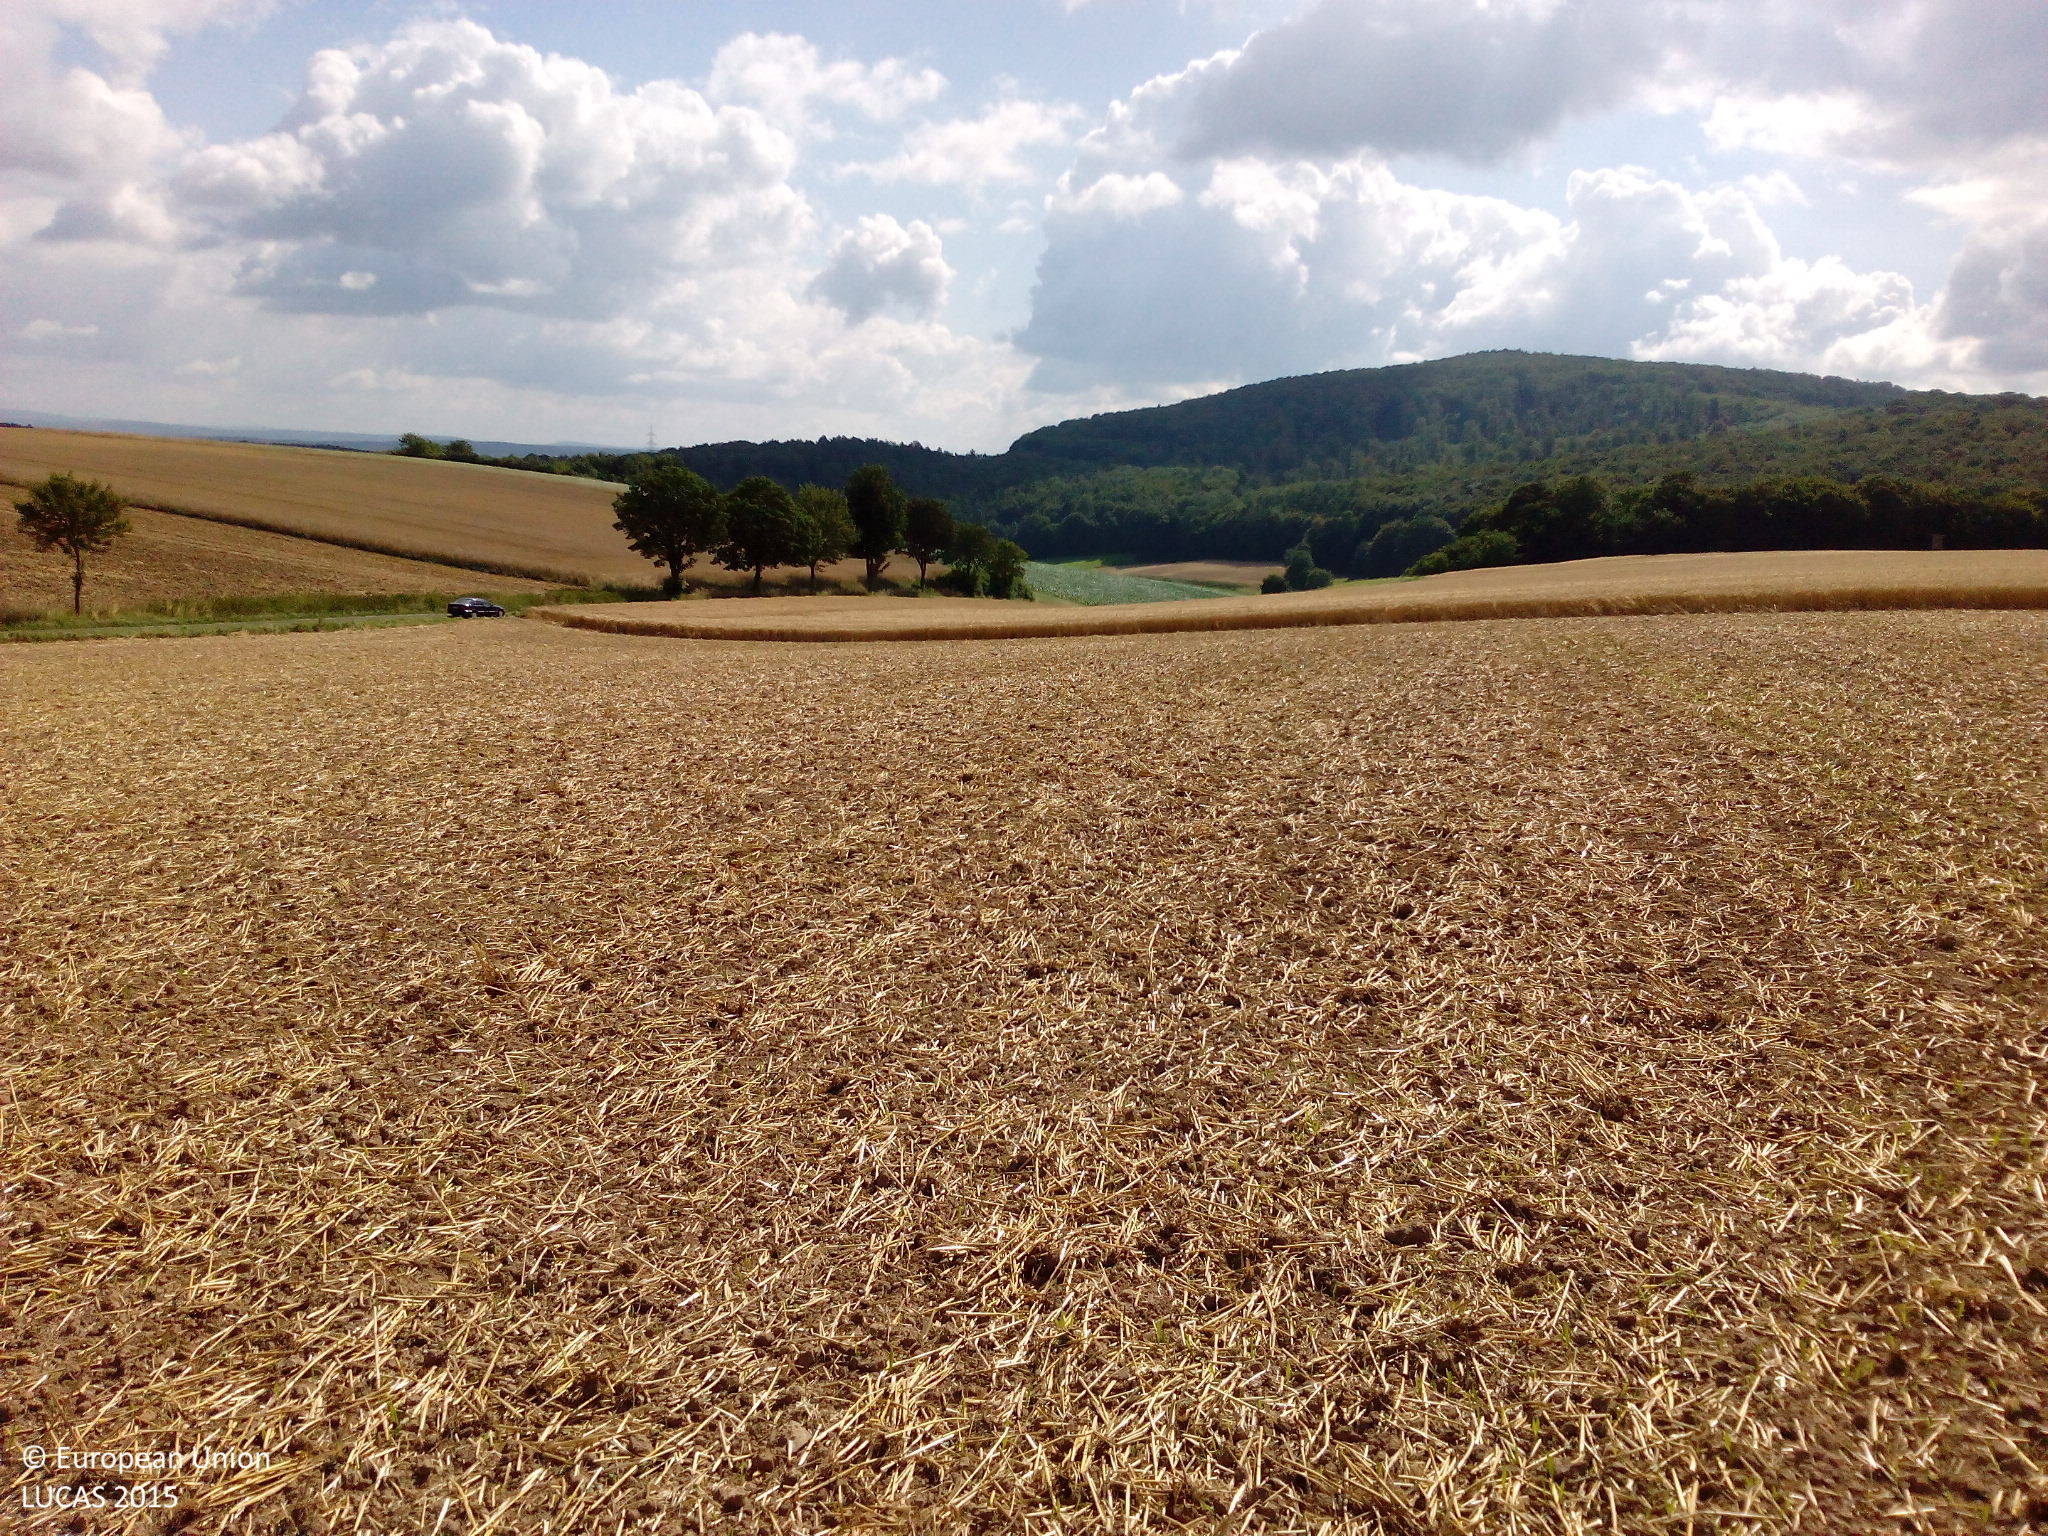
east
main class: Cropland
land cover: Rye
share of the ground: 10 - 25 %
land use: Agriculture (excluding fallow land and kitchen gardens)
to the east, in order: Rye; Grass margins; Paved roads, cycling and walking lanes
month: July
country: DE
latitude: 51.5848
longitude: 9.3507
